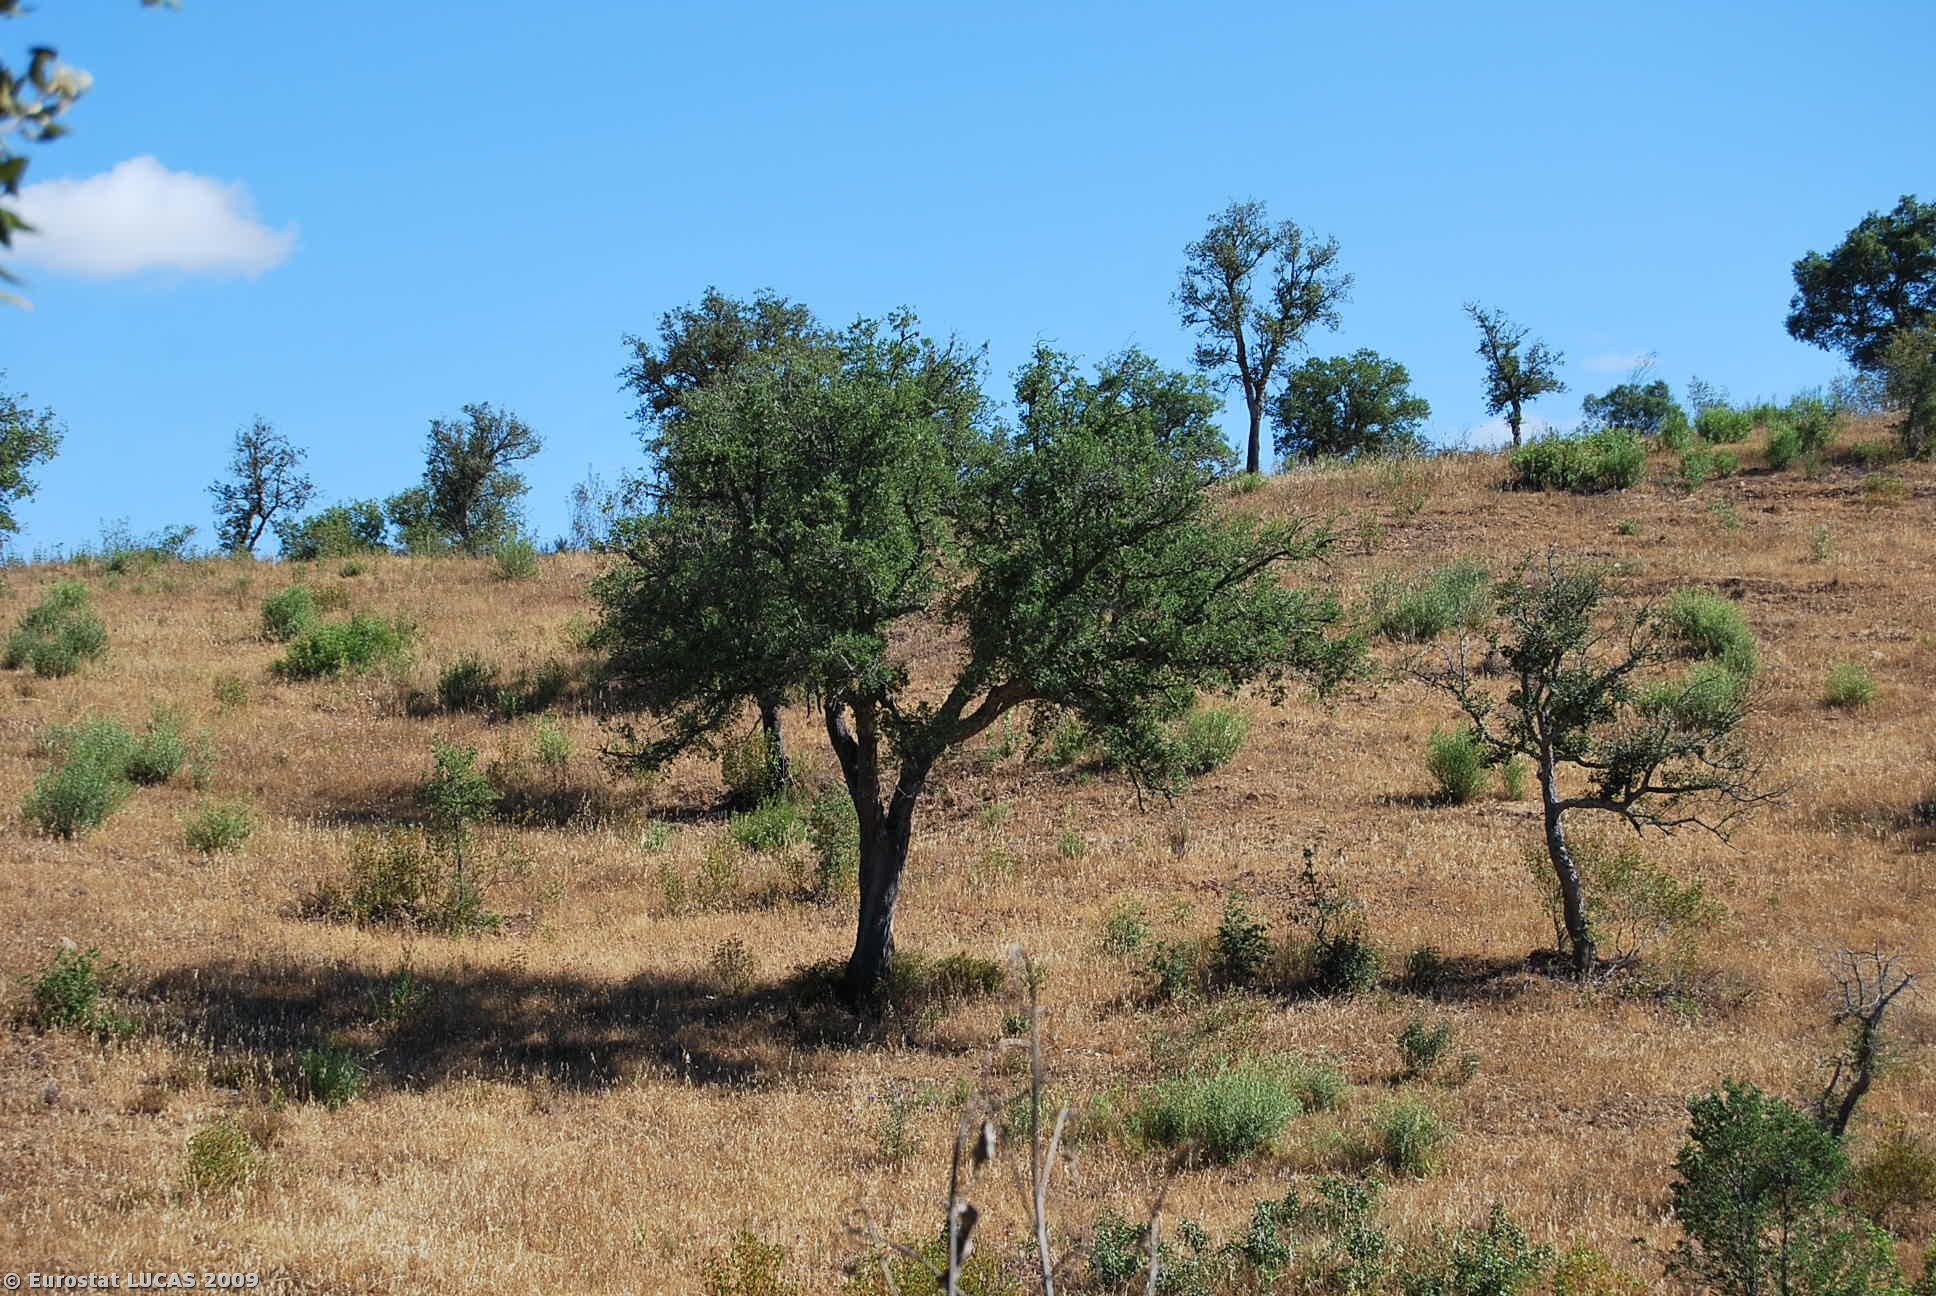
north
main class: Woodland
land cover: Broadleaved woodland
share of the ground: 25 - 50 %
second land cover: Shrubland with sparse tree cover
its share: 50 - 75 %
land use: Unused
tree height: < 5 m
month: June
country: PT
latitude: 37.9599
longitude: -8.5619
